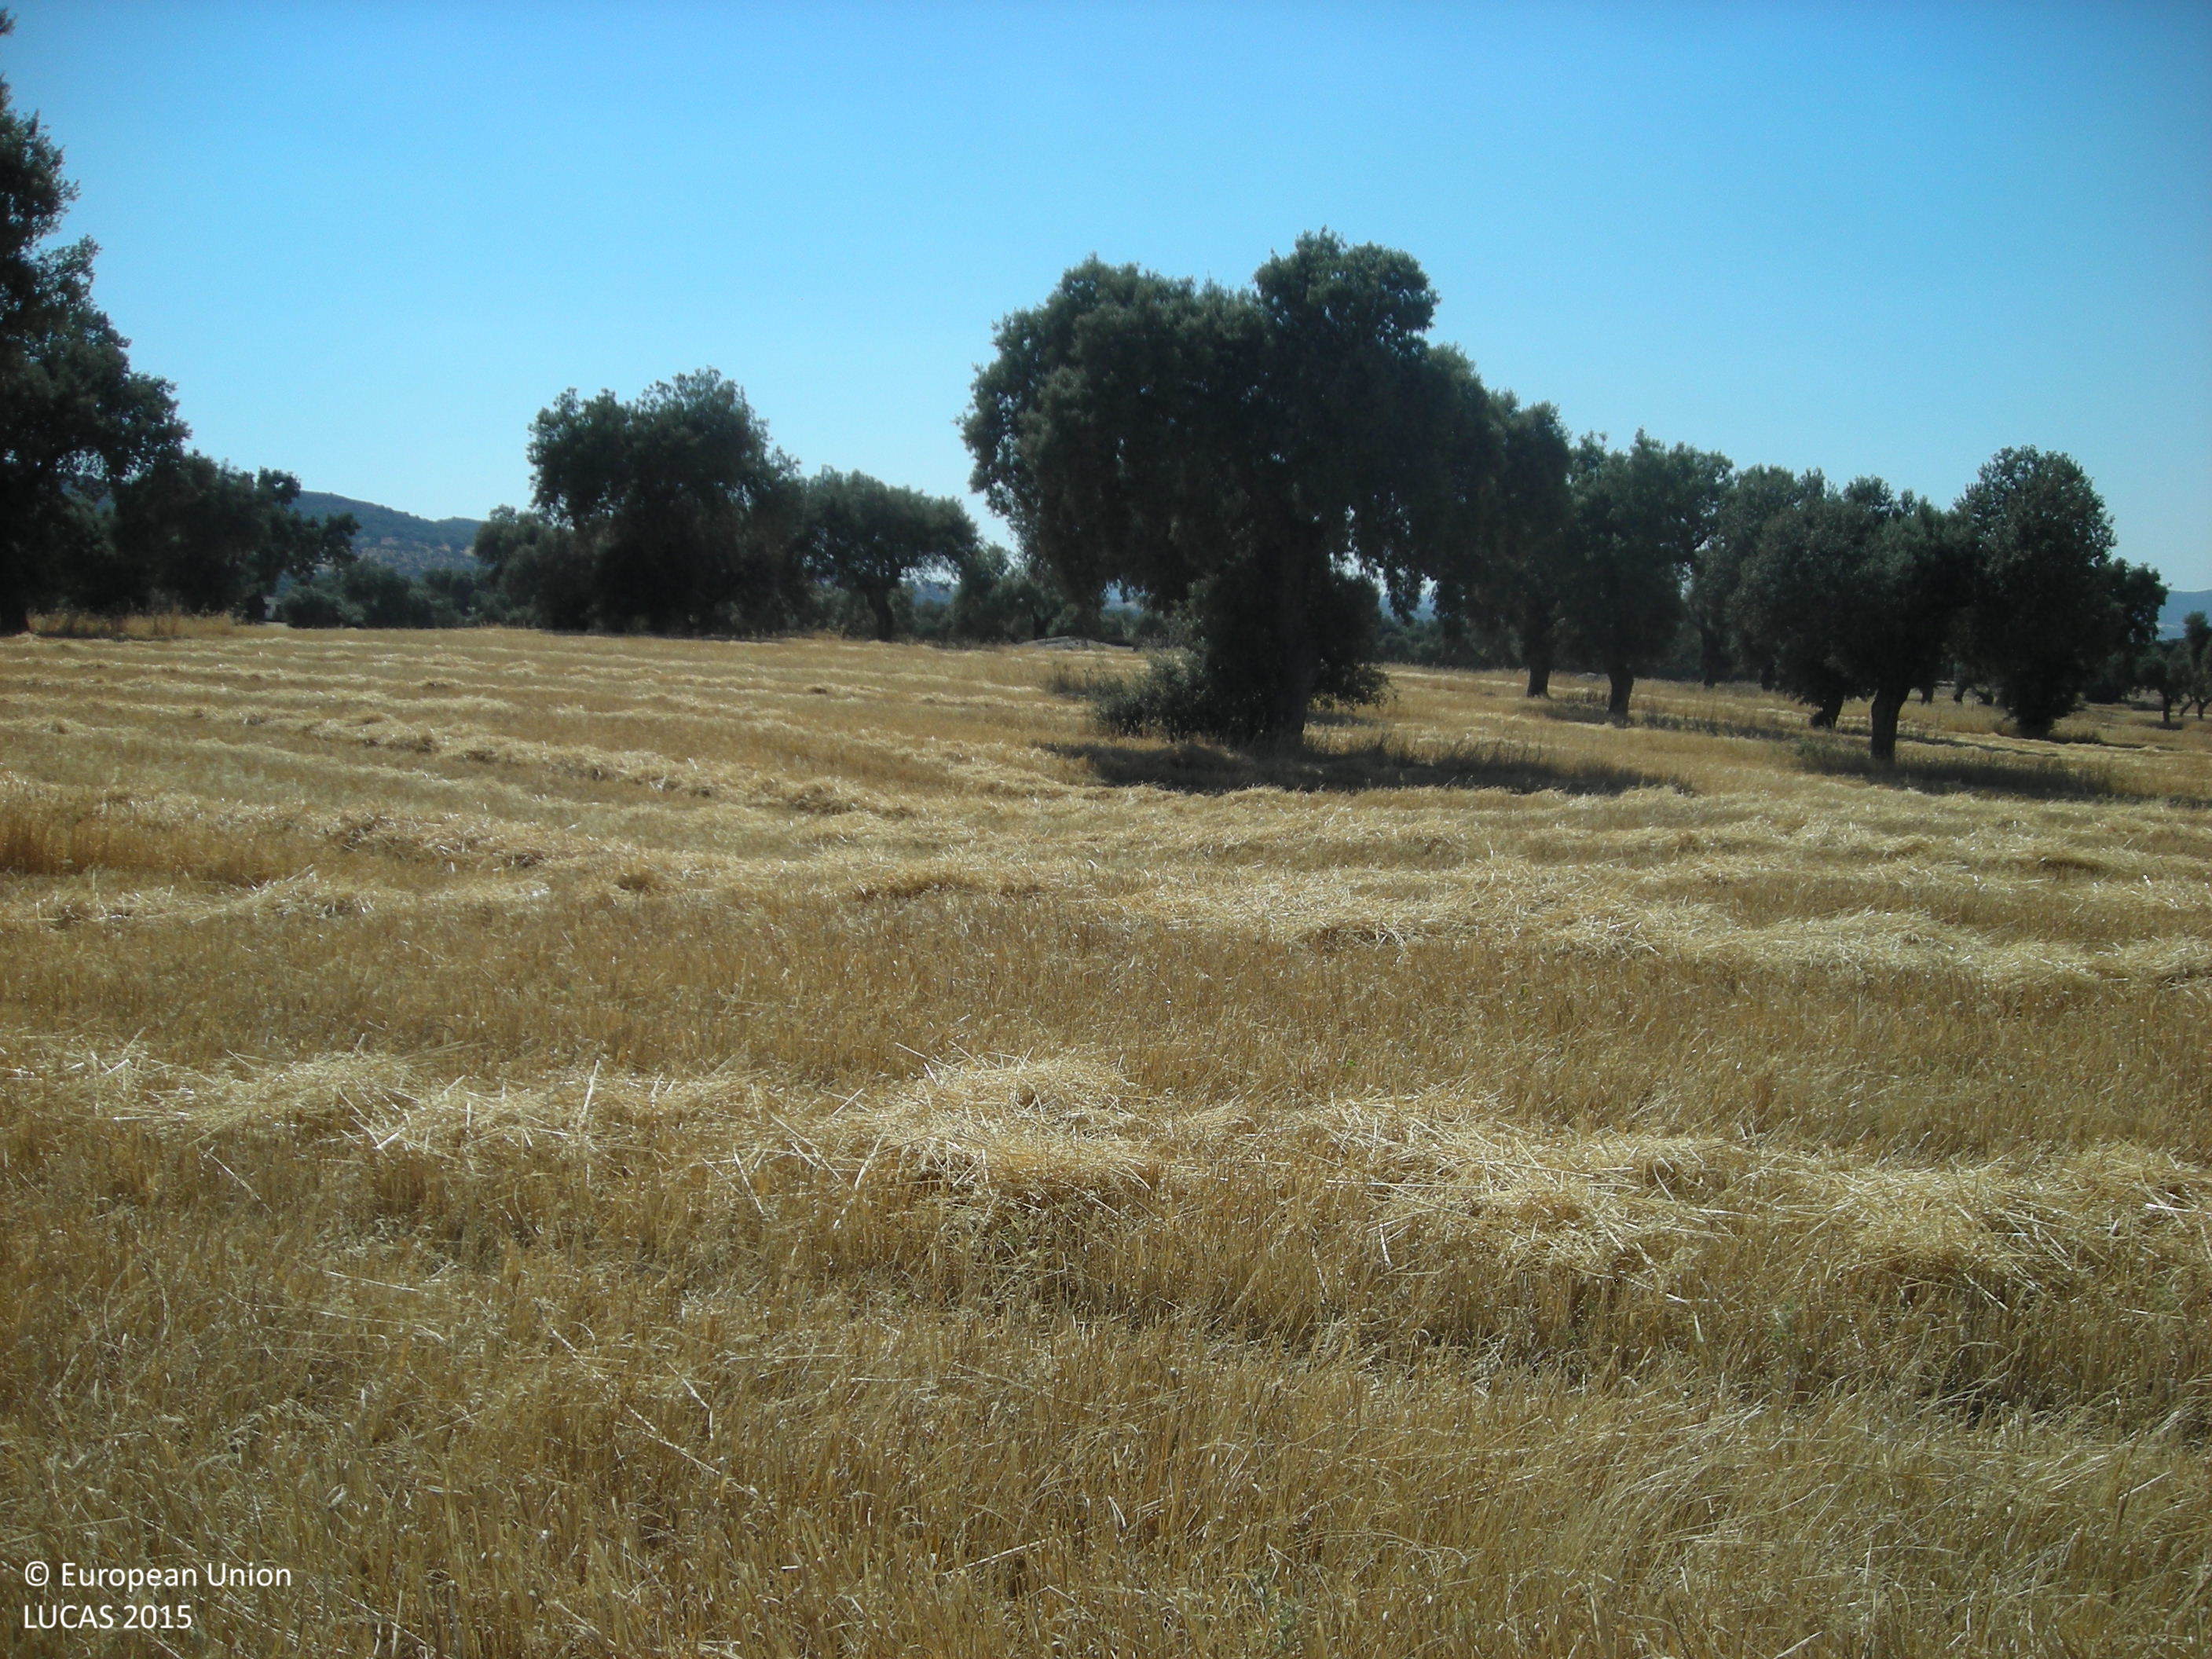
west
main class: Cropland
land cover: Mixed cereals for fodder
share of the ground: > 75 %
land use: Agriculture (excluding fallow land and kitchen gardens)
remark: Harvested field
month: June
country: ES
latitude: 38.6195
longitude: -5.7421
